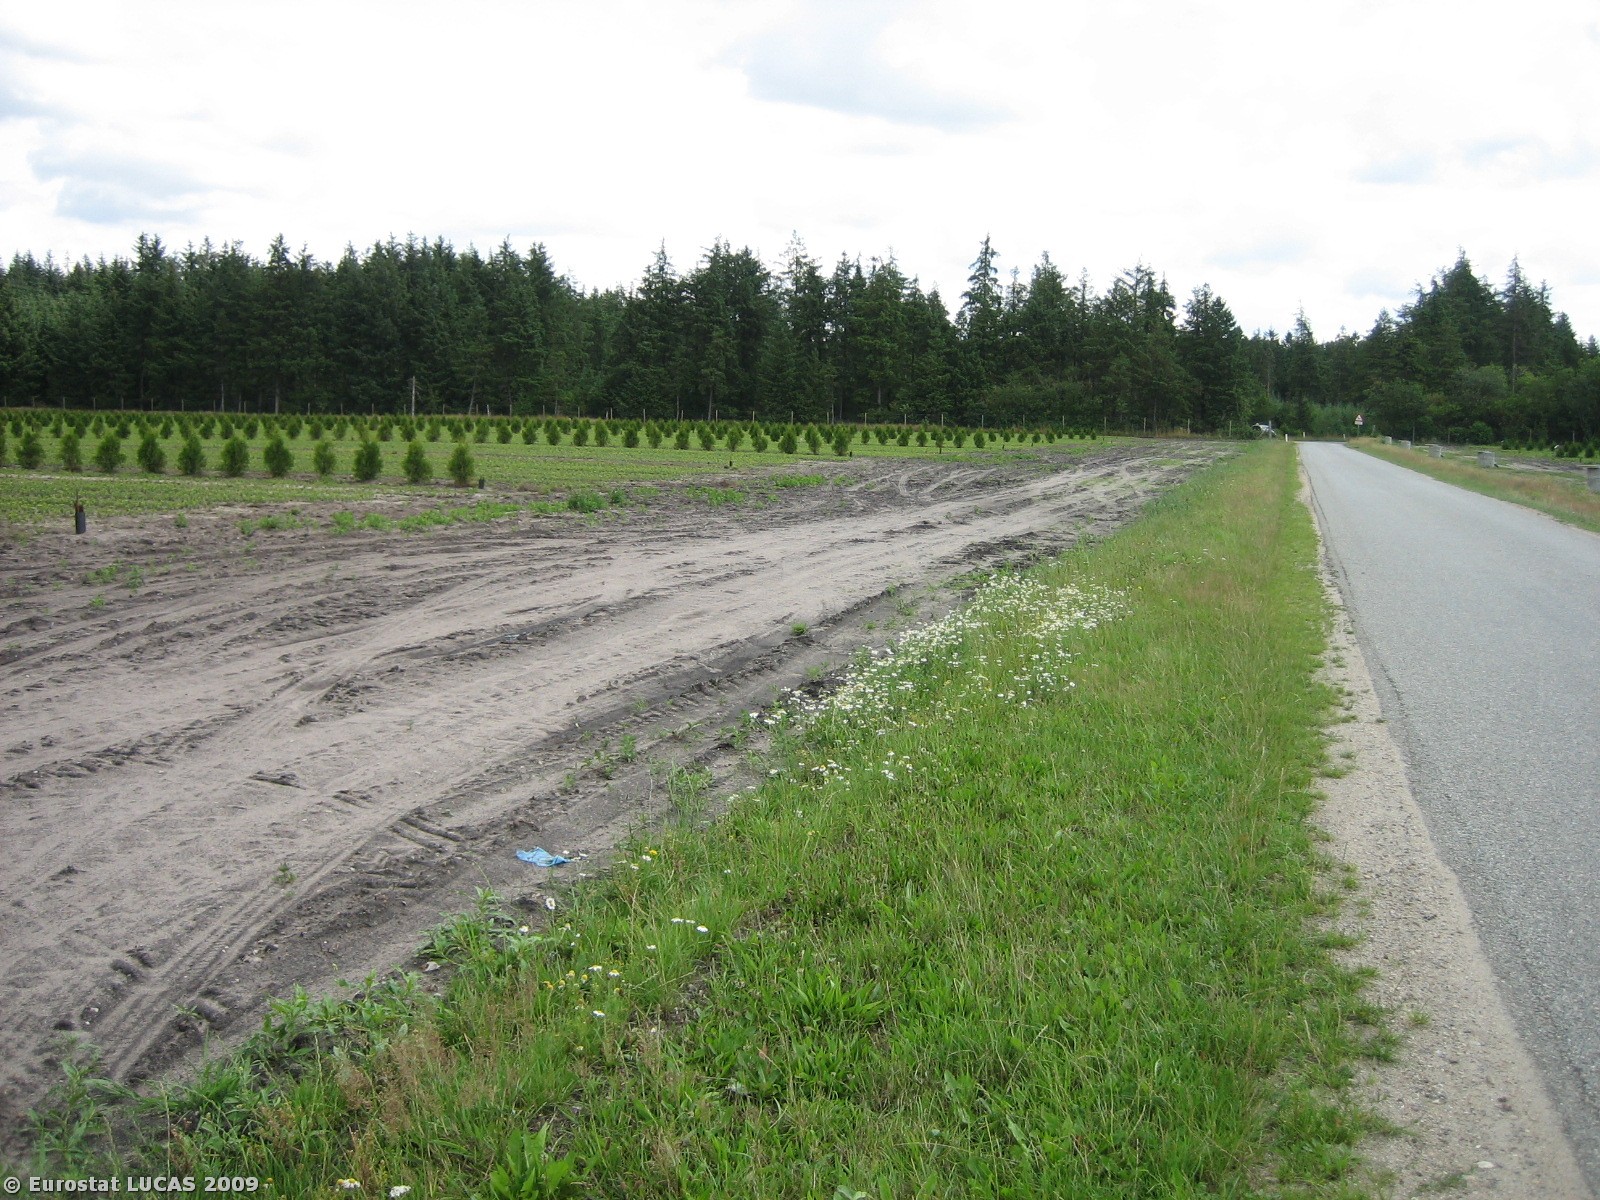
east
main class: Cropland
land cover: Nurseries
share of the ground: 50 - 75 %
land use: Agriculture (excluding fallow land and kitchen gardens)
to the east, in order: Nurseries; Coniferous woodland; Nurseries; Grass margins; Fences; Ditches and canals; Coniferous woodland
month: July
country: DK
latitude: 55.8058
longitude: 8.9321
